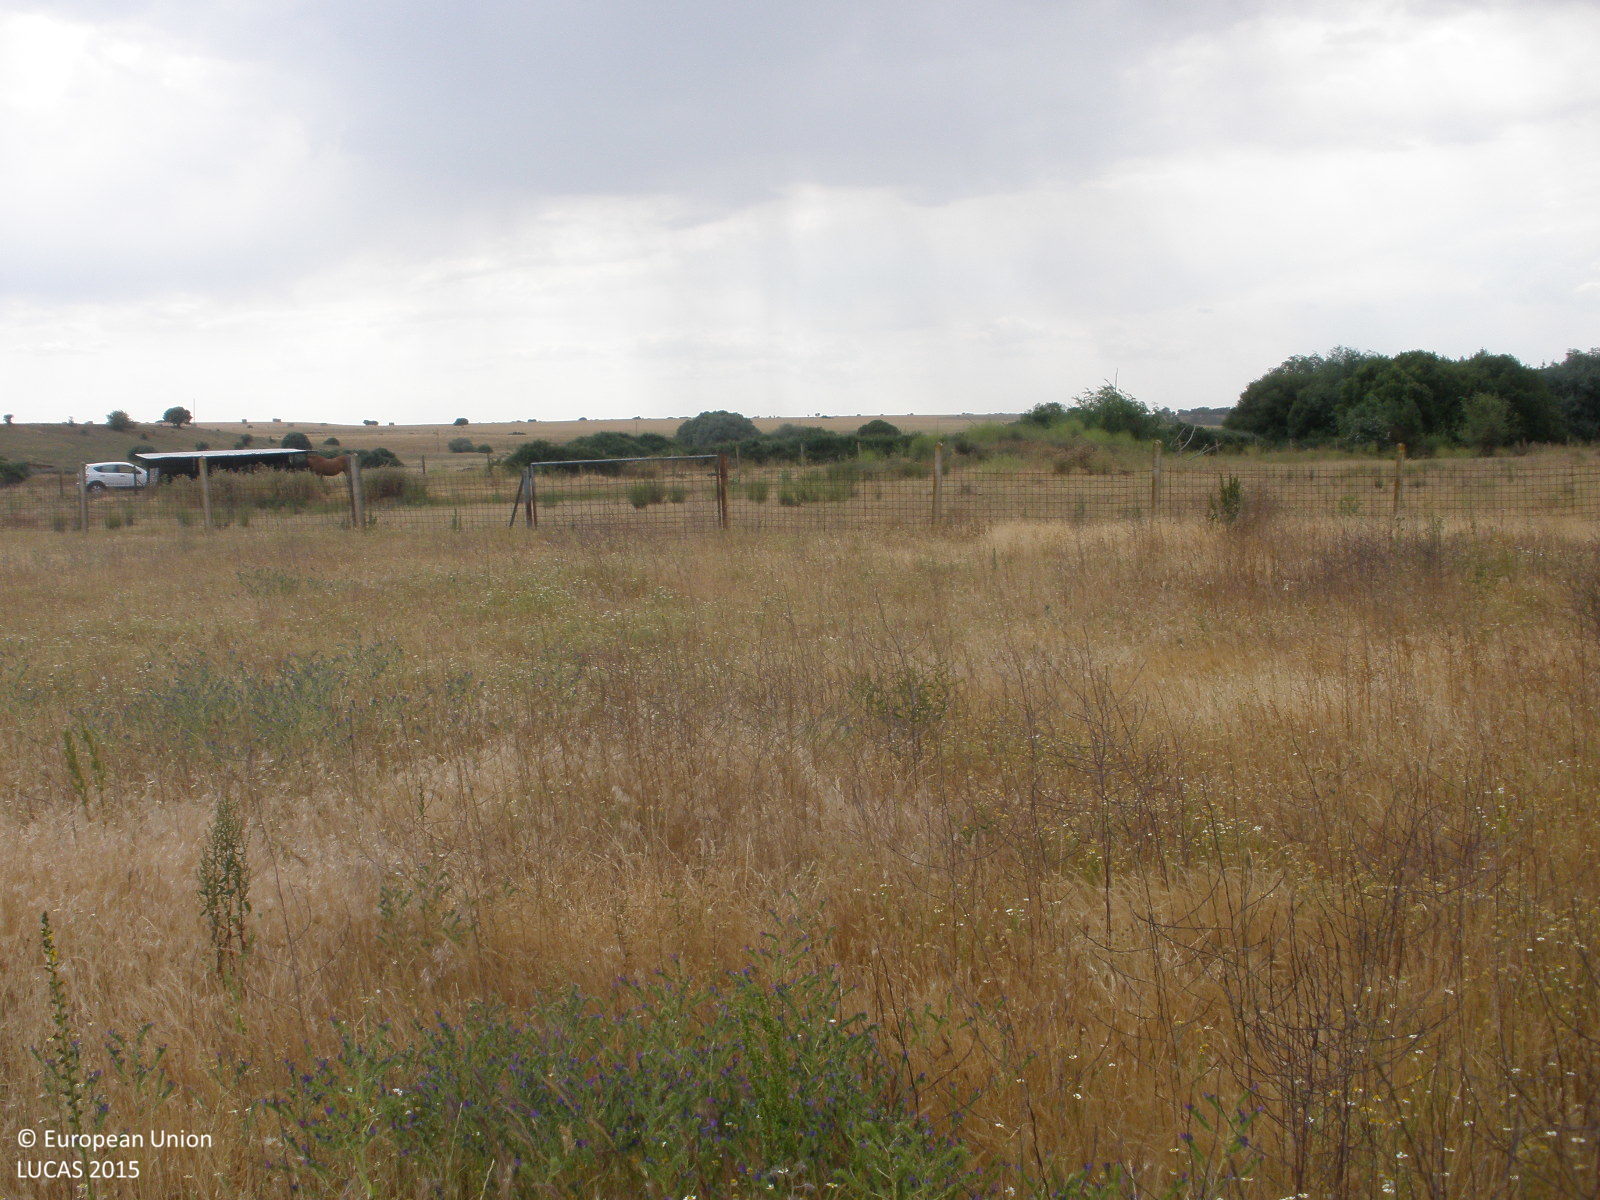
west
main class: Grassland
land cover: Grassland without tree/shrub cover
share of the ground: > 75 %
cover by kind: herbaceous plants 100 %
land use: Agriculture (excluding fallow land and kitchen gardens)
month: June
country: ES
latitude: 40.7152
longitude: -6.1954
